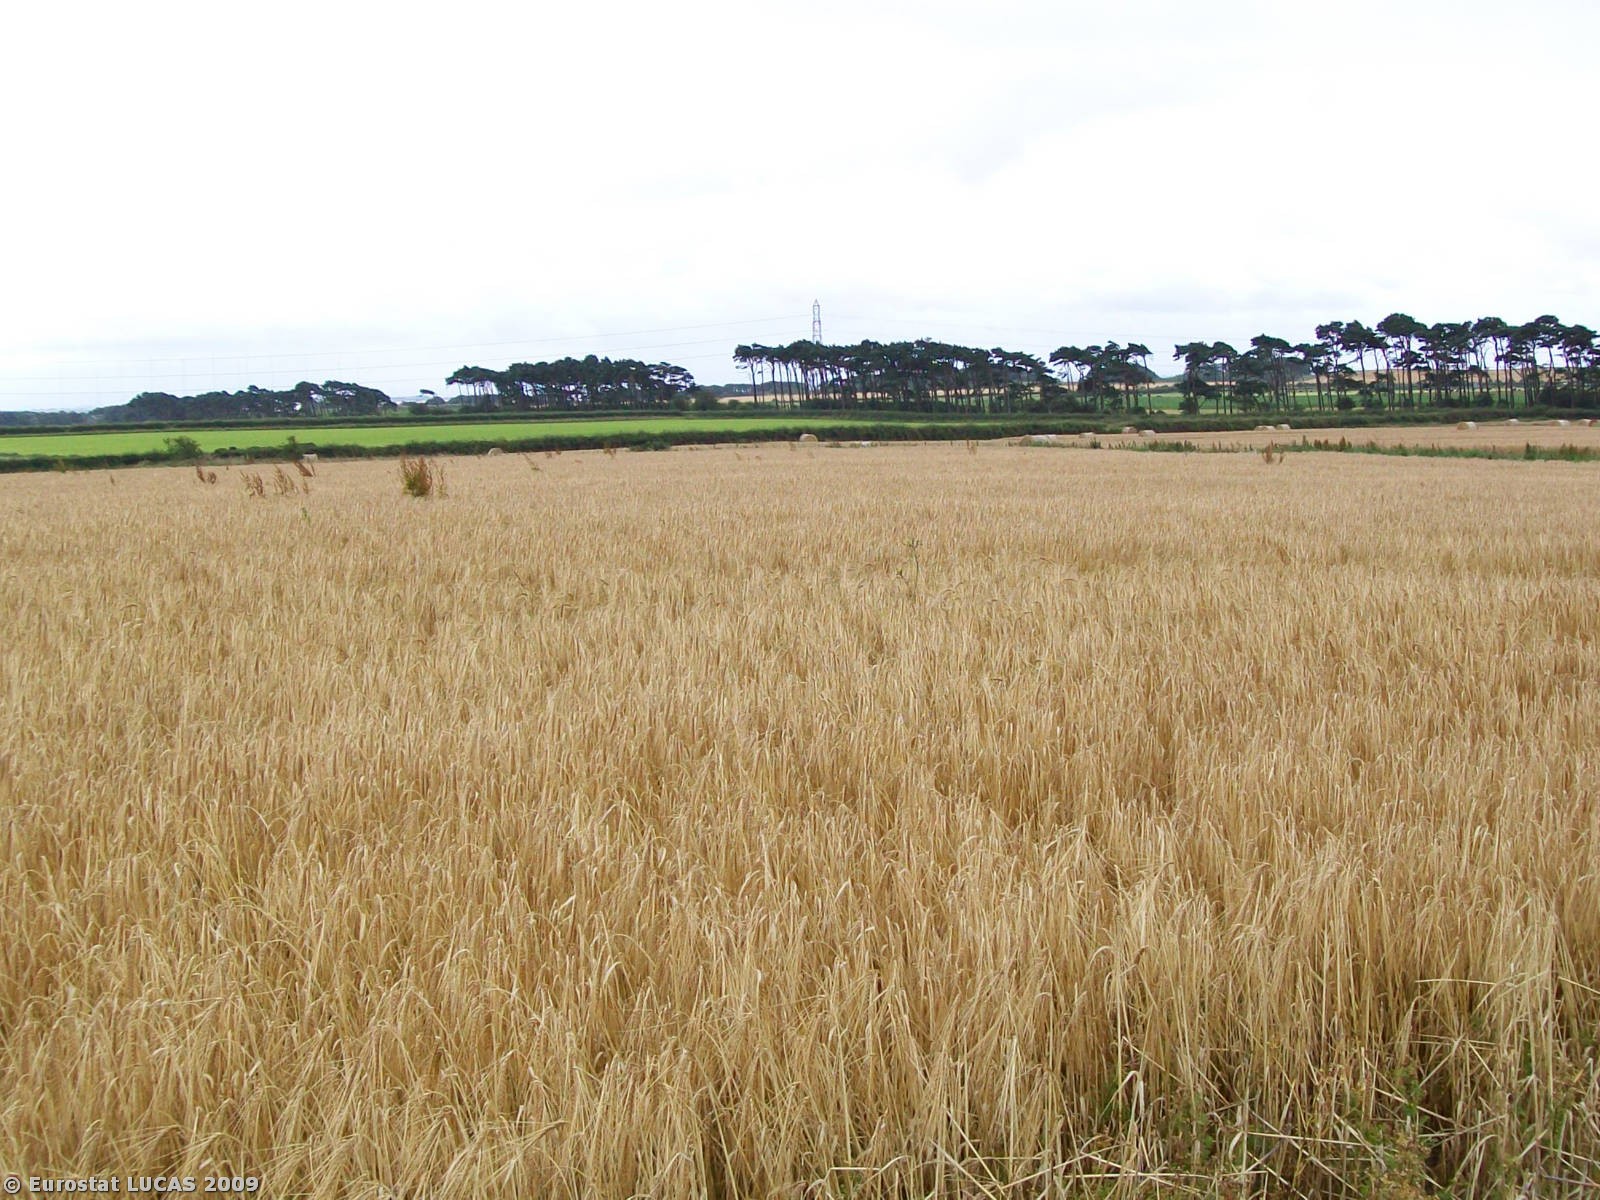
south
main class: Cropland
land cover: Barley
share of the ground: > 75 %
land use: Agriculture (excluding fallow land and kitchen gardens)
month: July
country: GB
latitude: 54.9968
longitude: -3.3172
